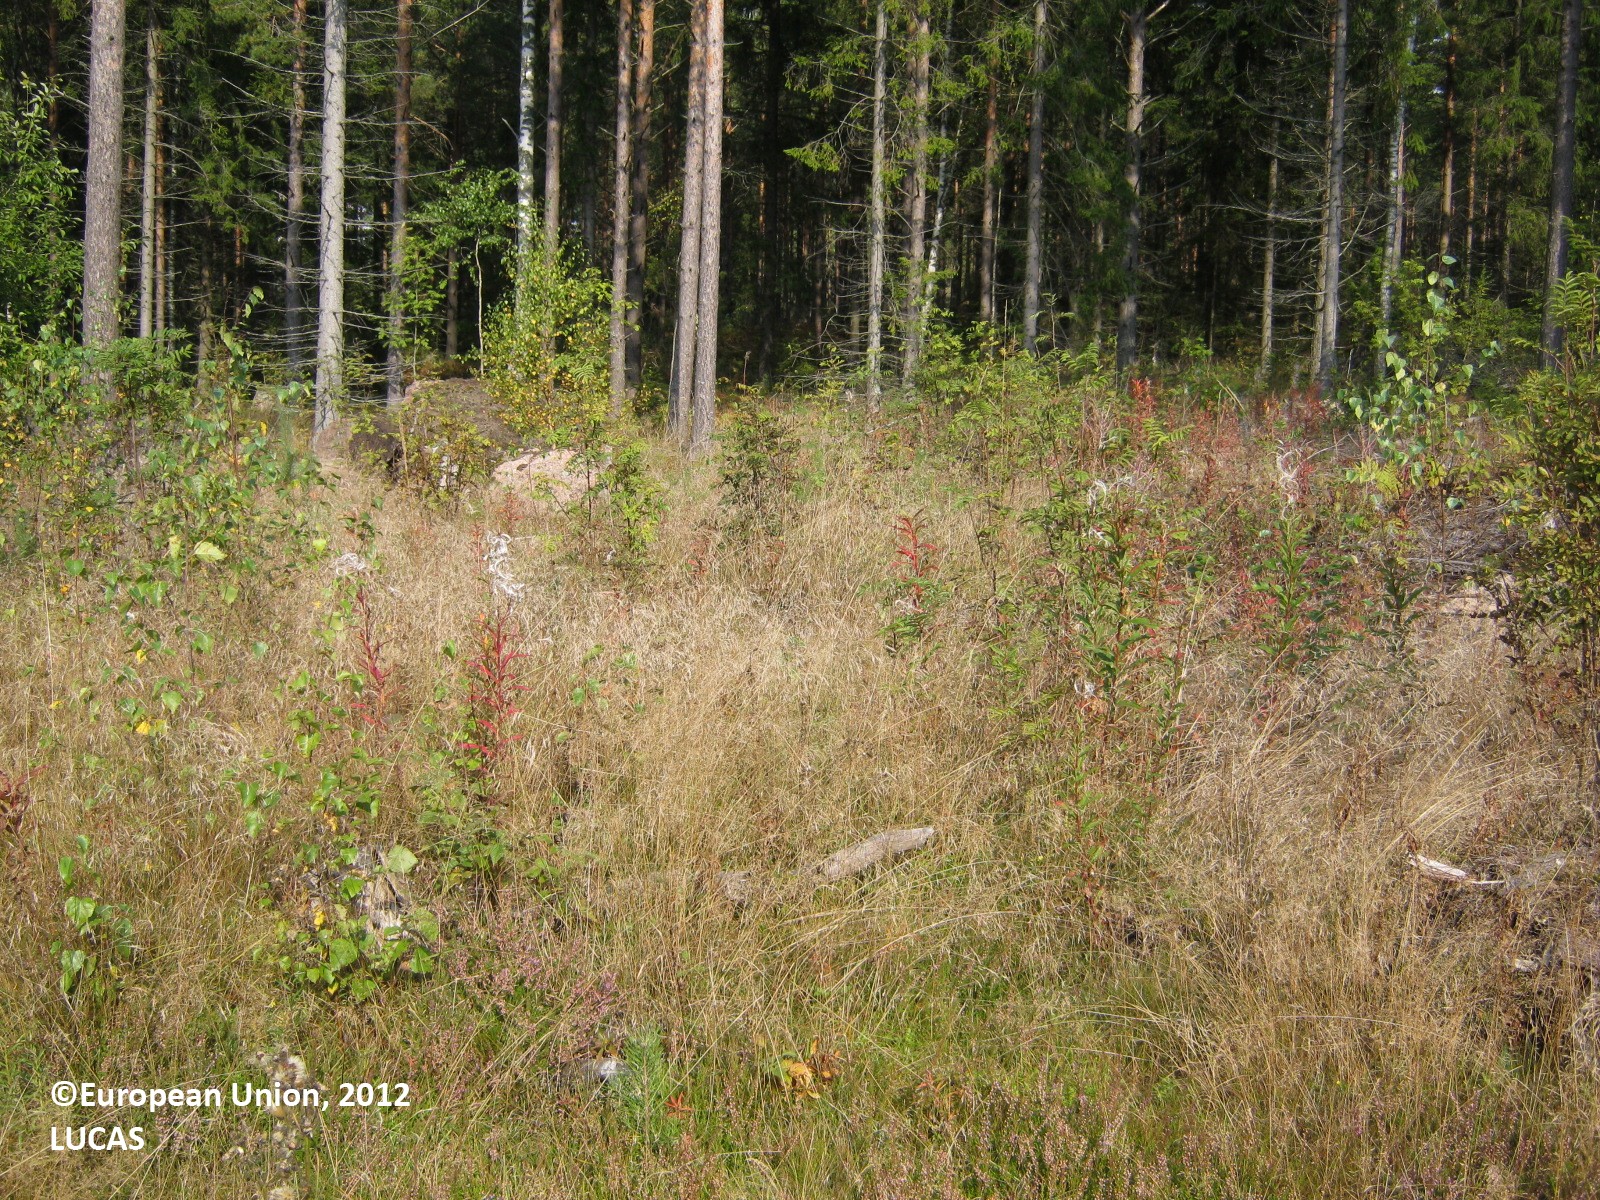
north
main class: Woodland
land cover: Broadleaved woodland
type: boreal forest
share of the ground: 25 - 50 %
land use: Forestry
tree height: < 5 m
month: September
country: FI
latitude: 60.5285
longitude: 27.7039
